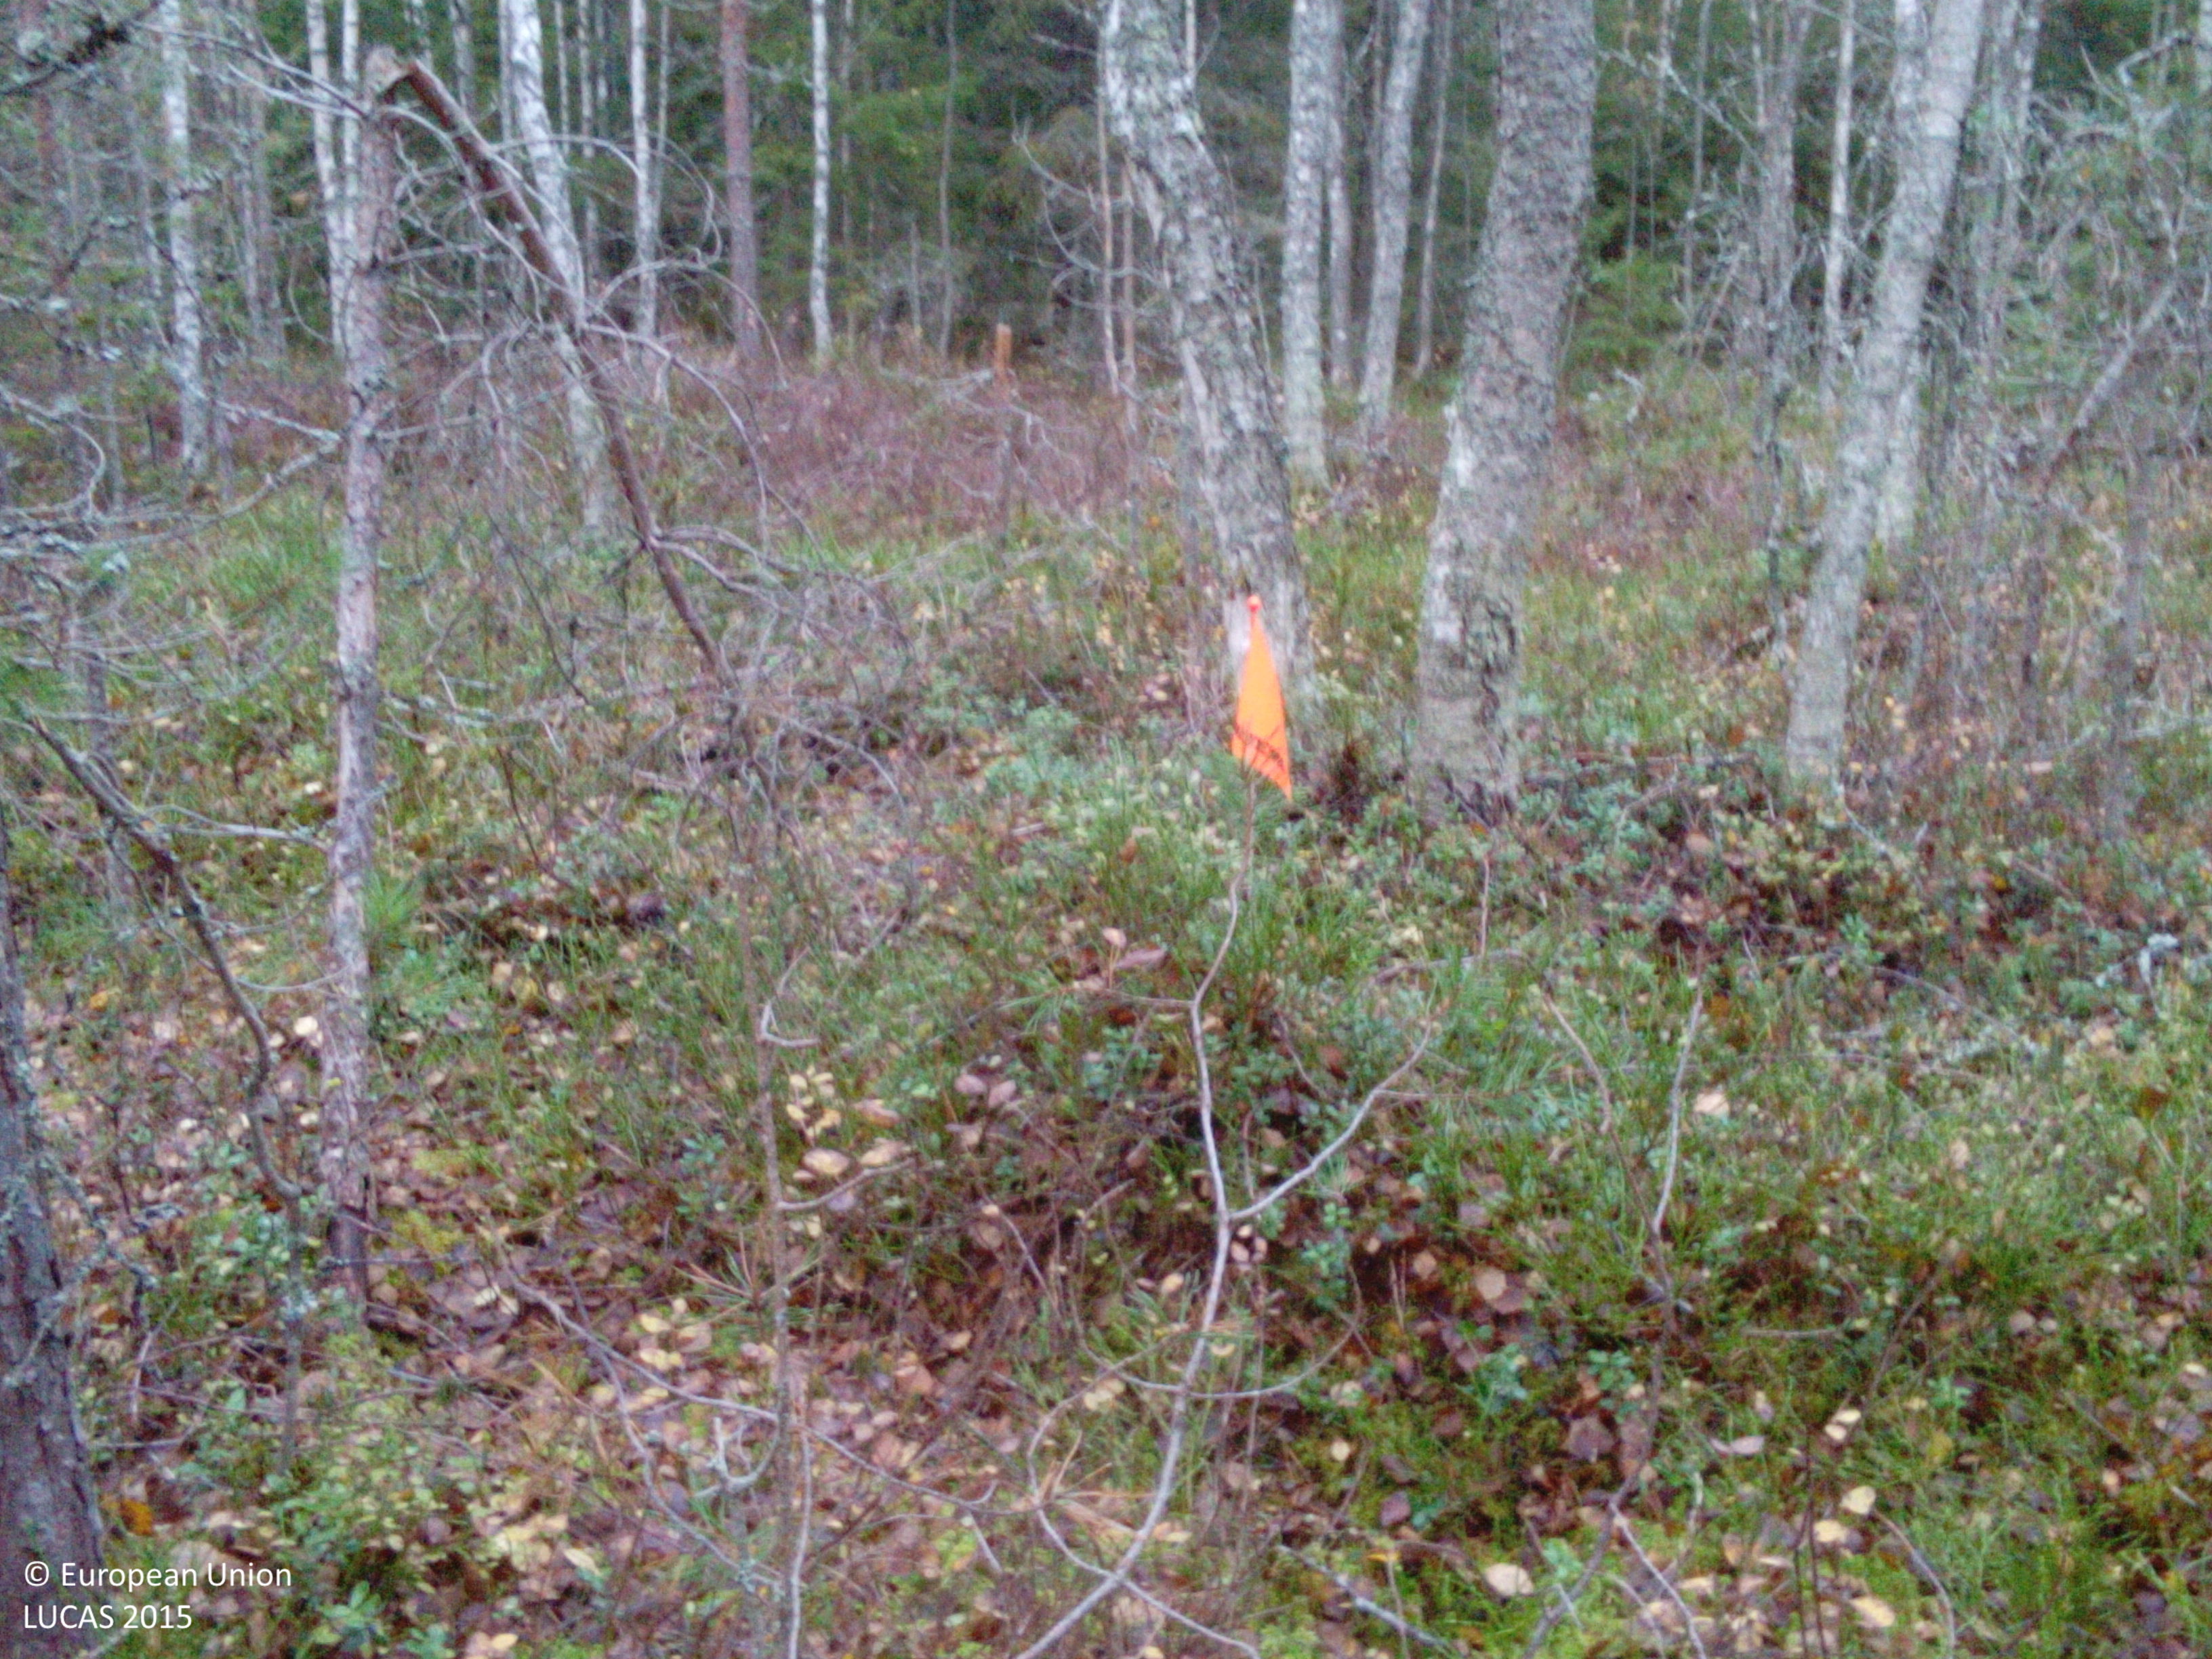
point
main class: Woodland
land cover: Pine dominated mixed woodland
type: boreal forest
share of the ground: > 75 %
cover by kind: coniferous forest trees 40 %, broadleaved forest trees 40 %, herbaceous plants 10 %, lichens and mosses 10 %
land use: Forestry
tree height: > 5 m
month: October
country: SE
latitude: 59.2557
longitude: 16.4648
